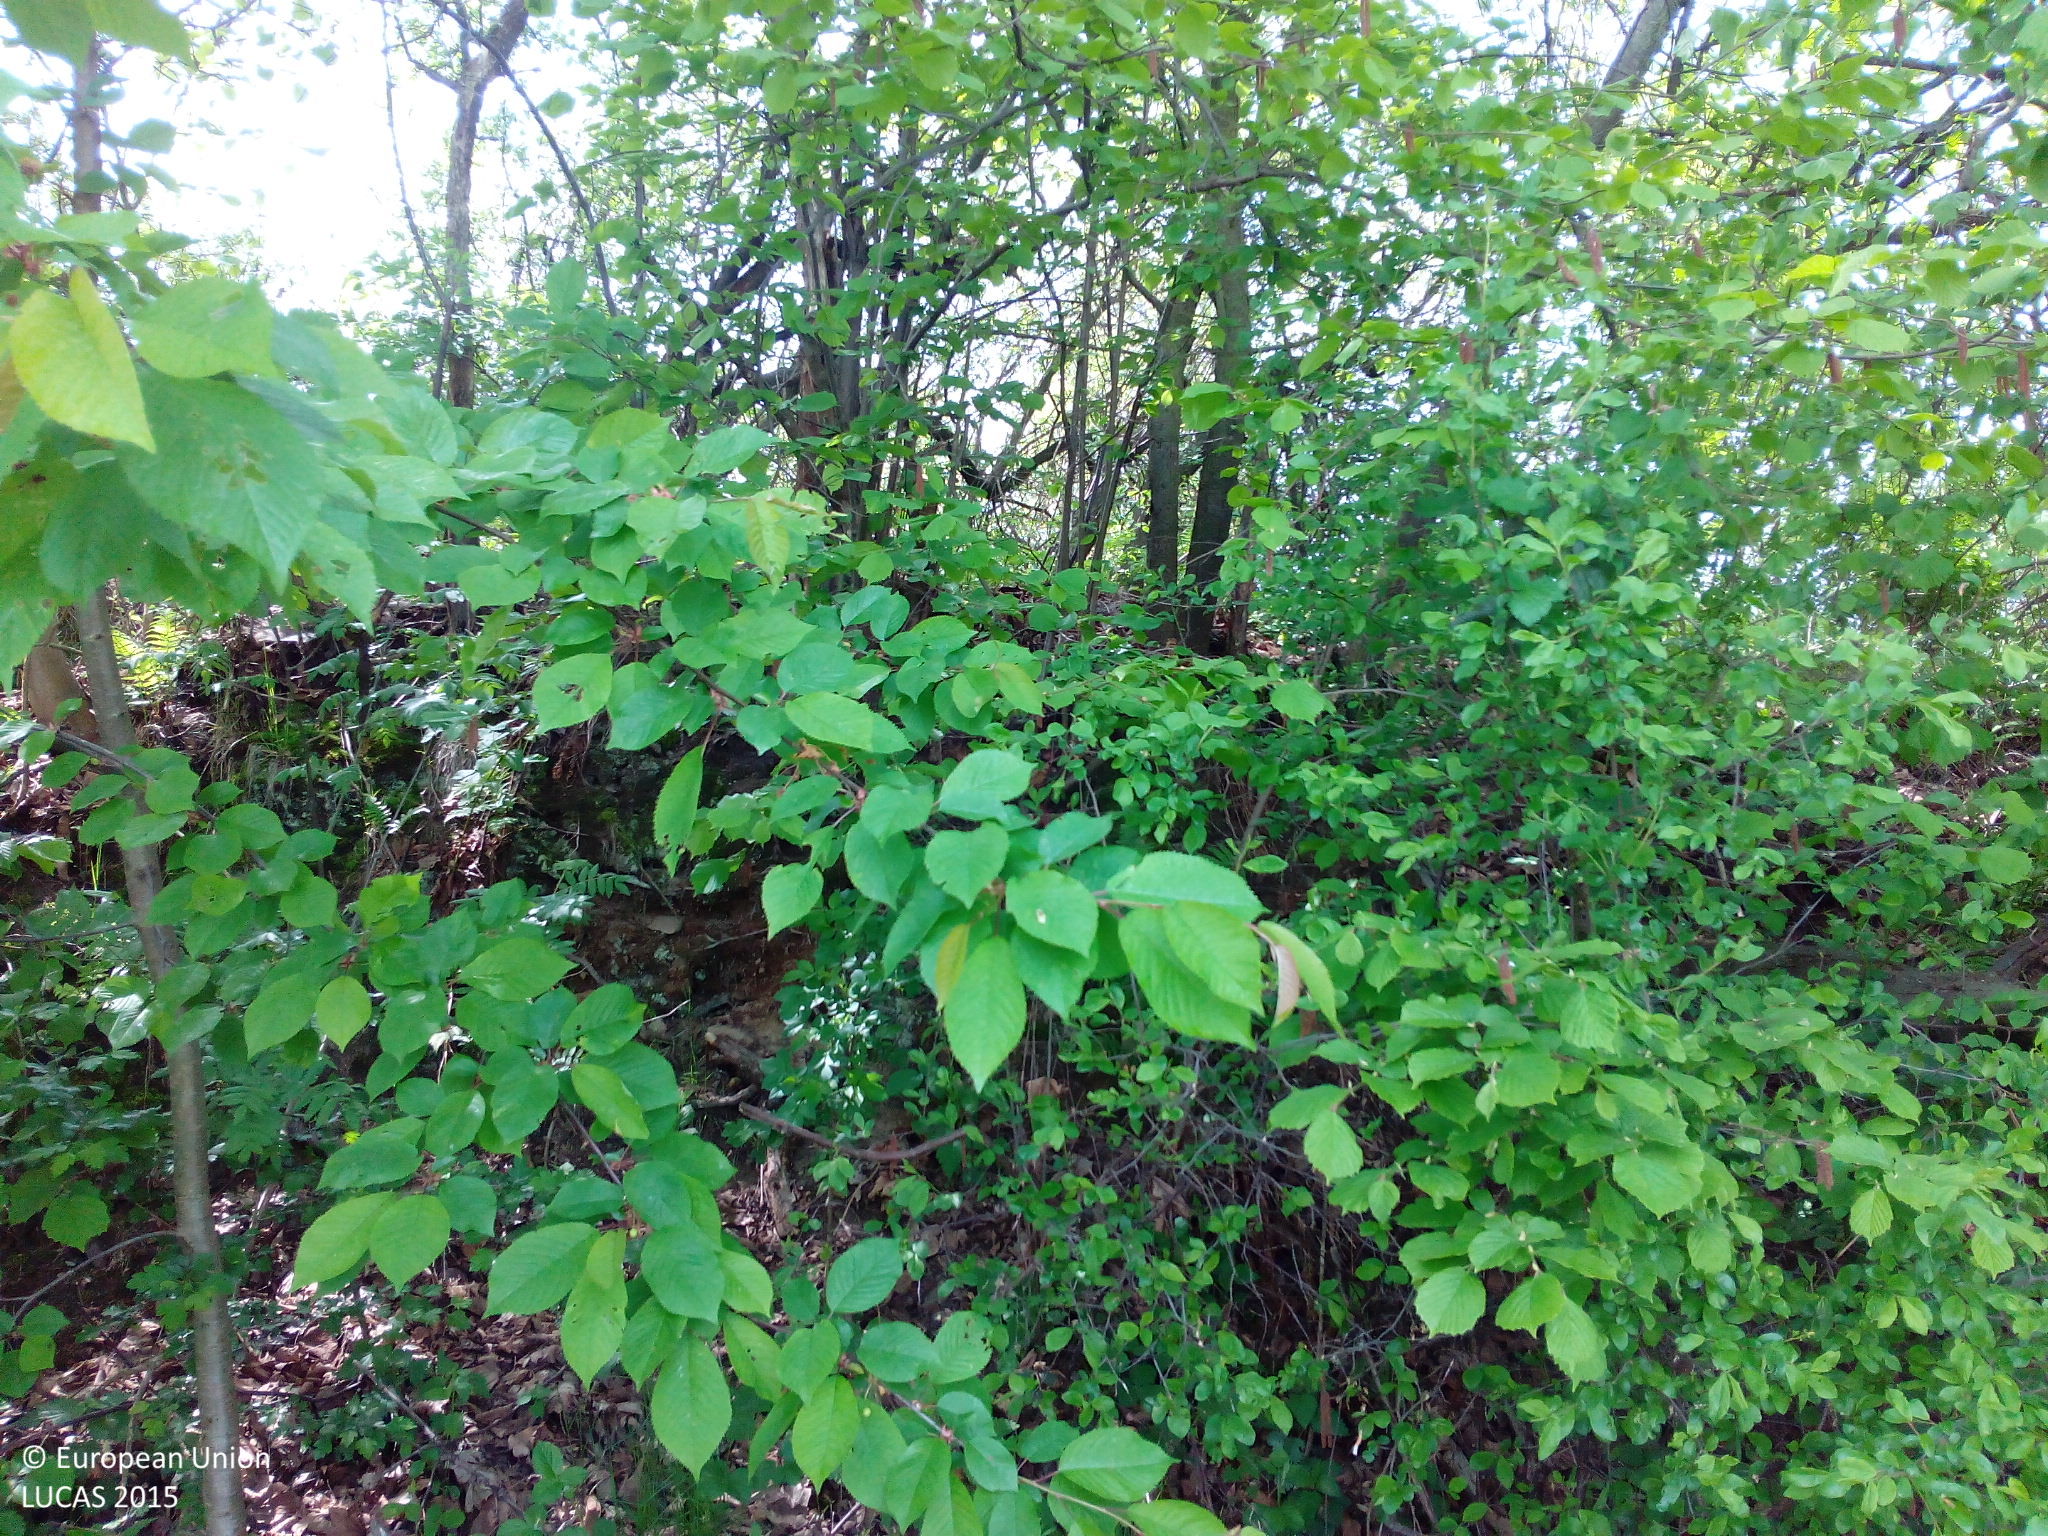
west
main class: Woodland
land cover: Broadleaved woodland
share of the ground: > 75 %
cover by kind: broadleaved forest trees 100 %
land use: Agriculture (excluding fallow land and kitchen gardens)
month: May
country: DE
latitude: 50.7725
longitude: 13.0772
